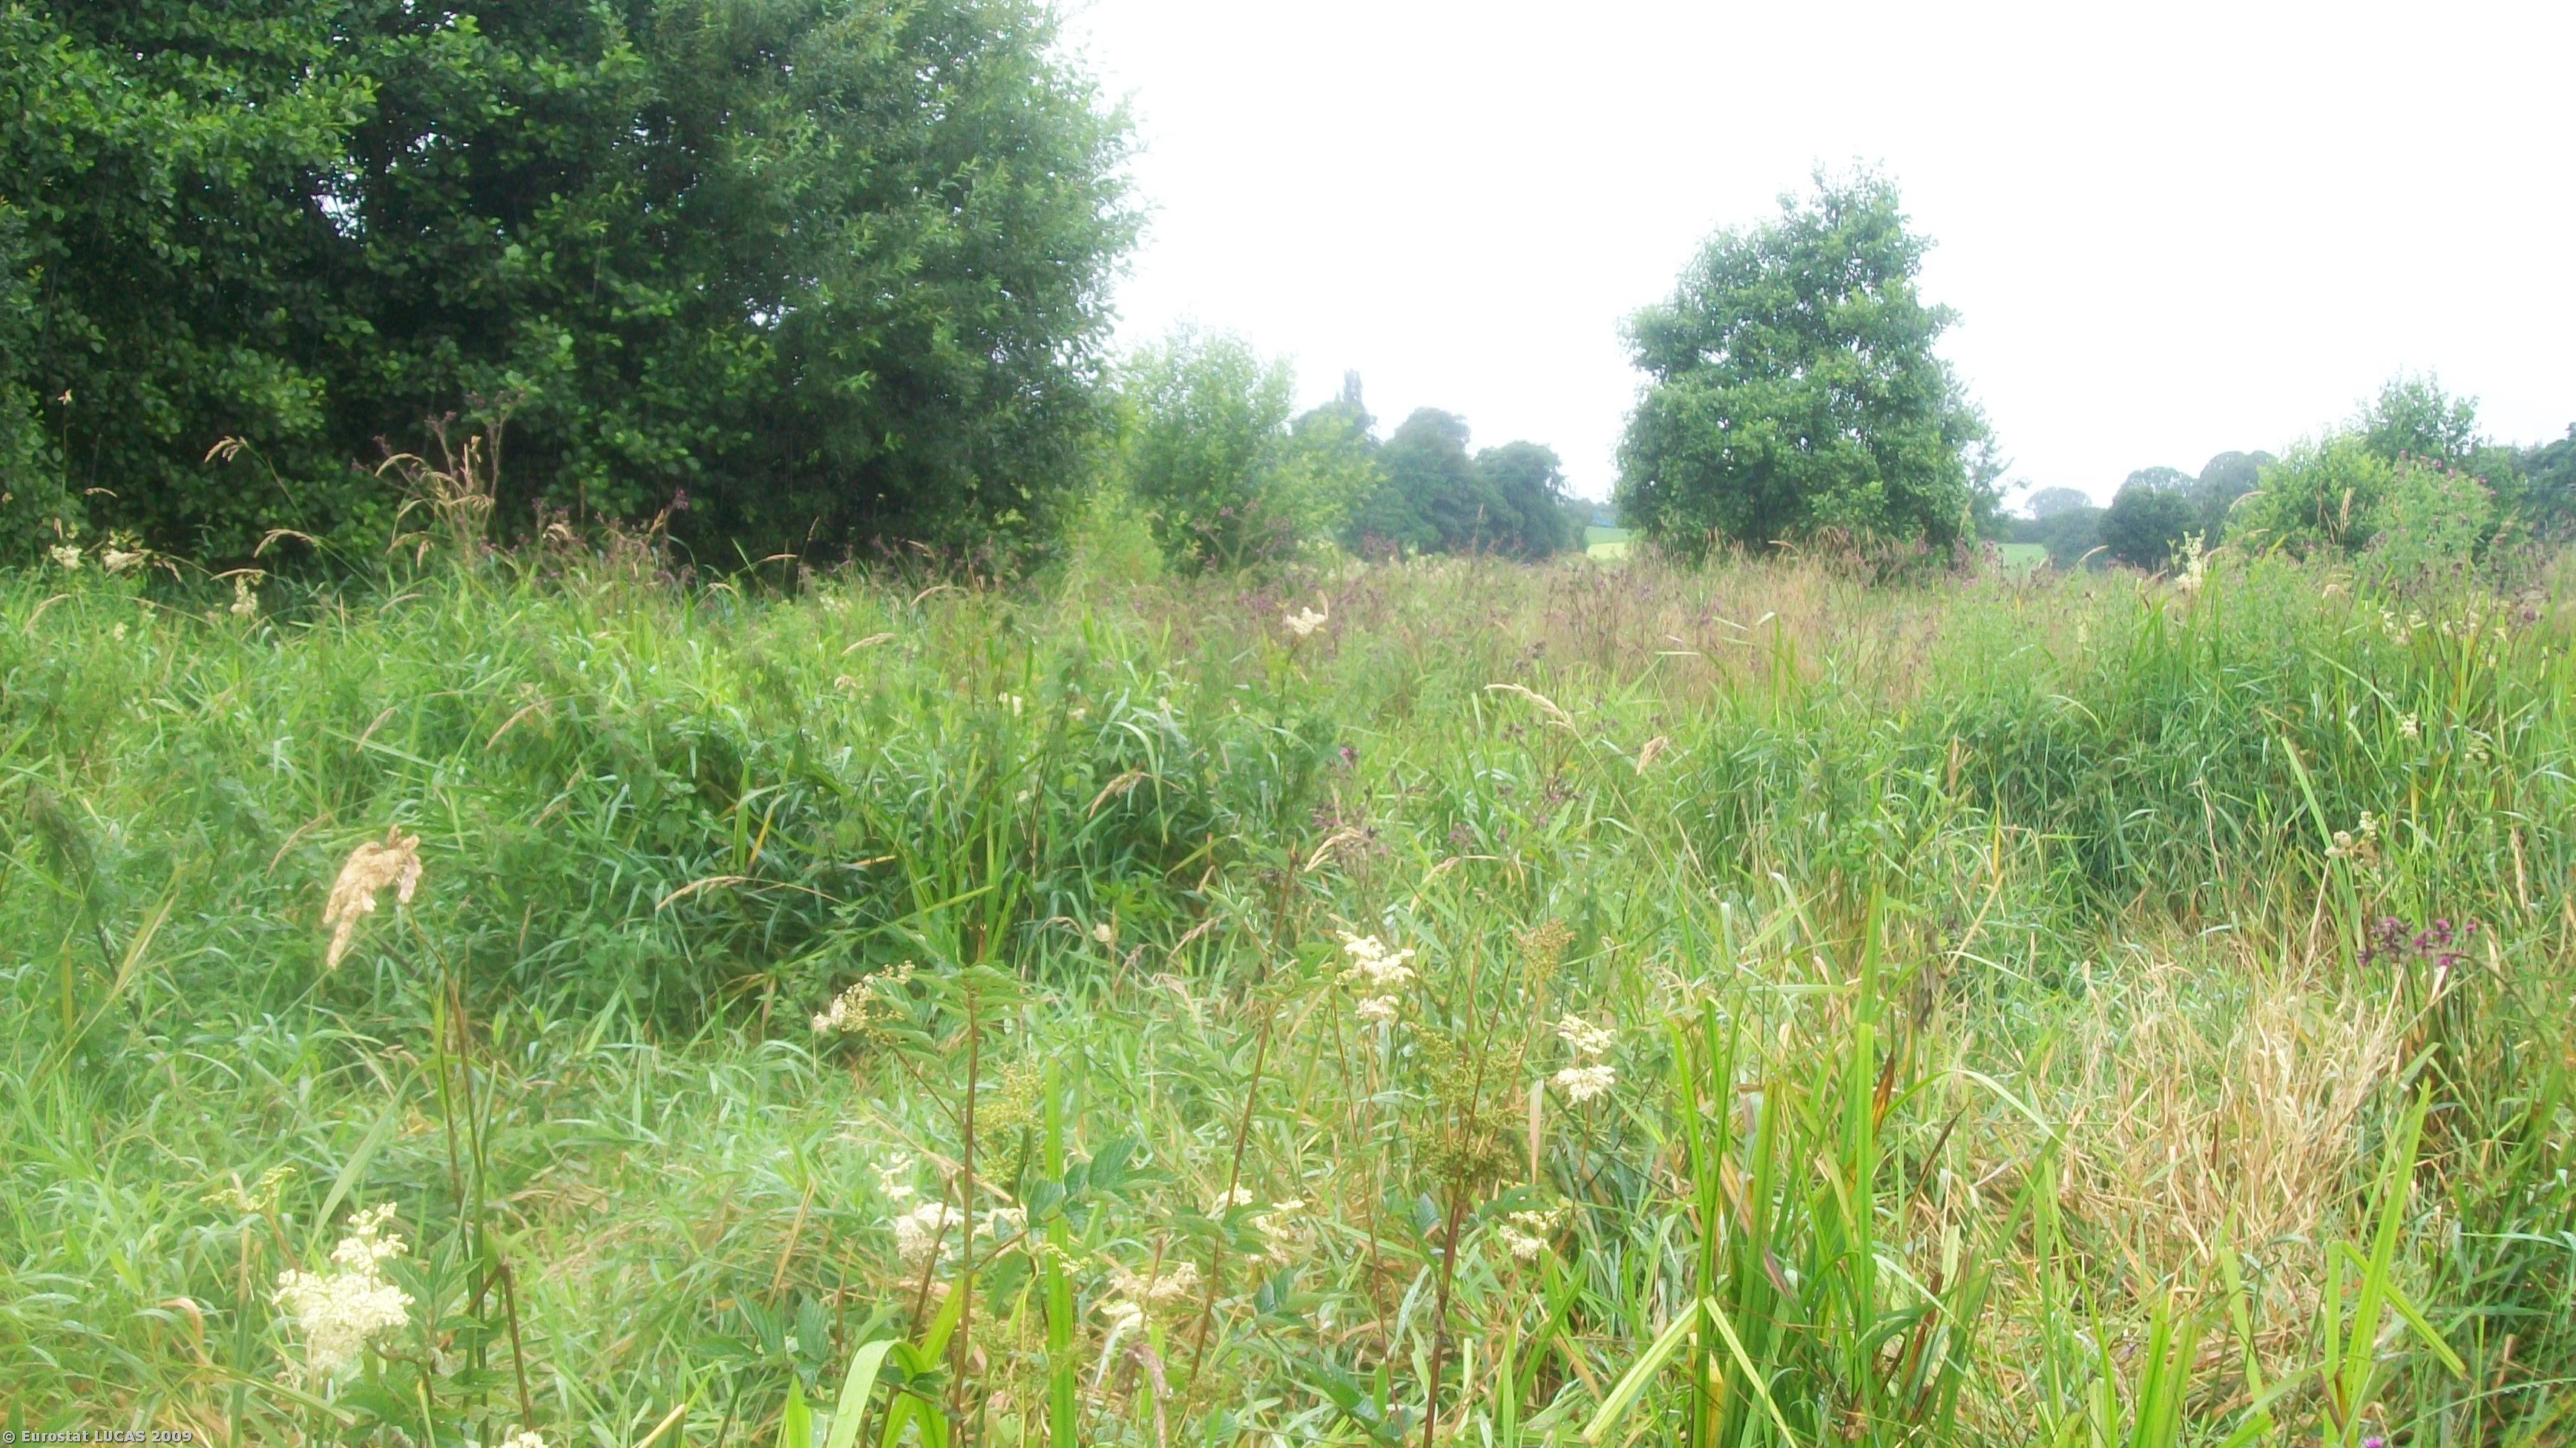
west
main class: Woodland
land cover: Broadleaved woodland
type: non-riverine alder, birch or aspen forest
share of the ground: > 75 %
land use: Unused
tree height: > 5 m
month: July
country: GB
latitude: 53.0070
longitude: -2.6617
